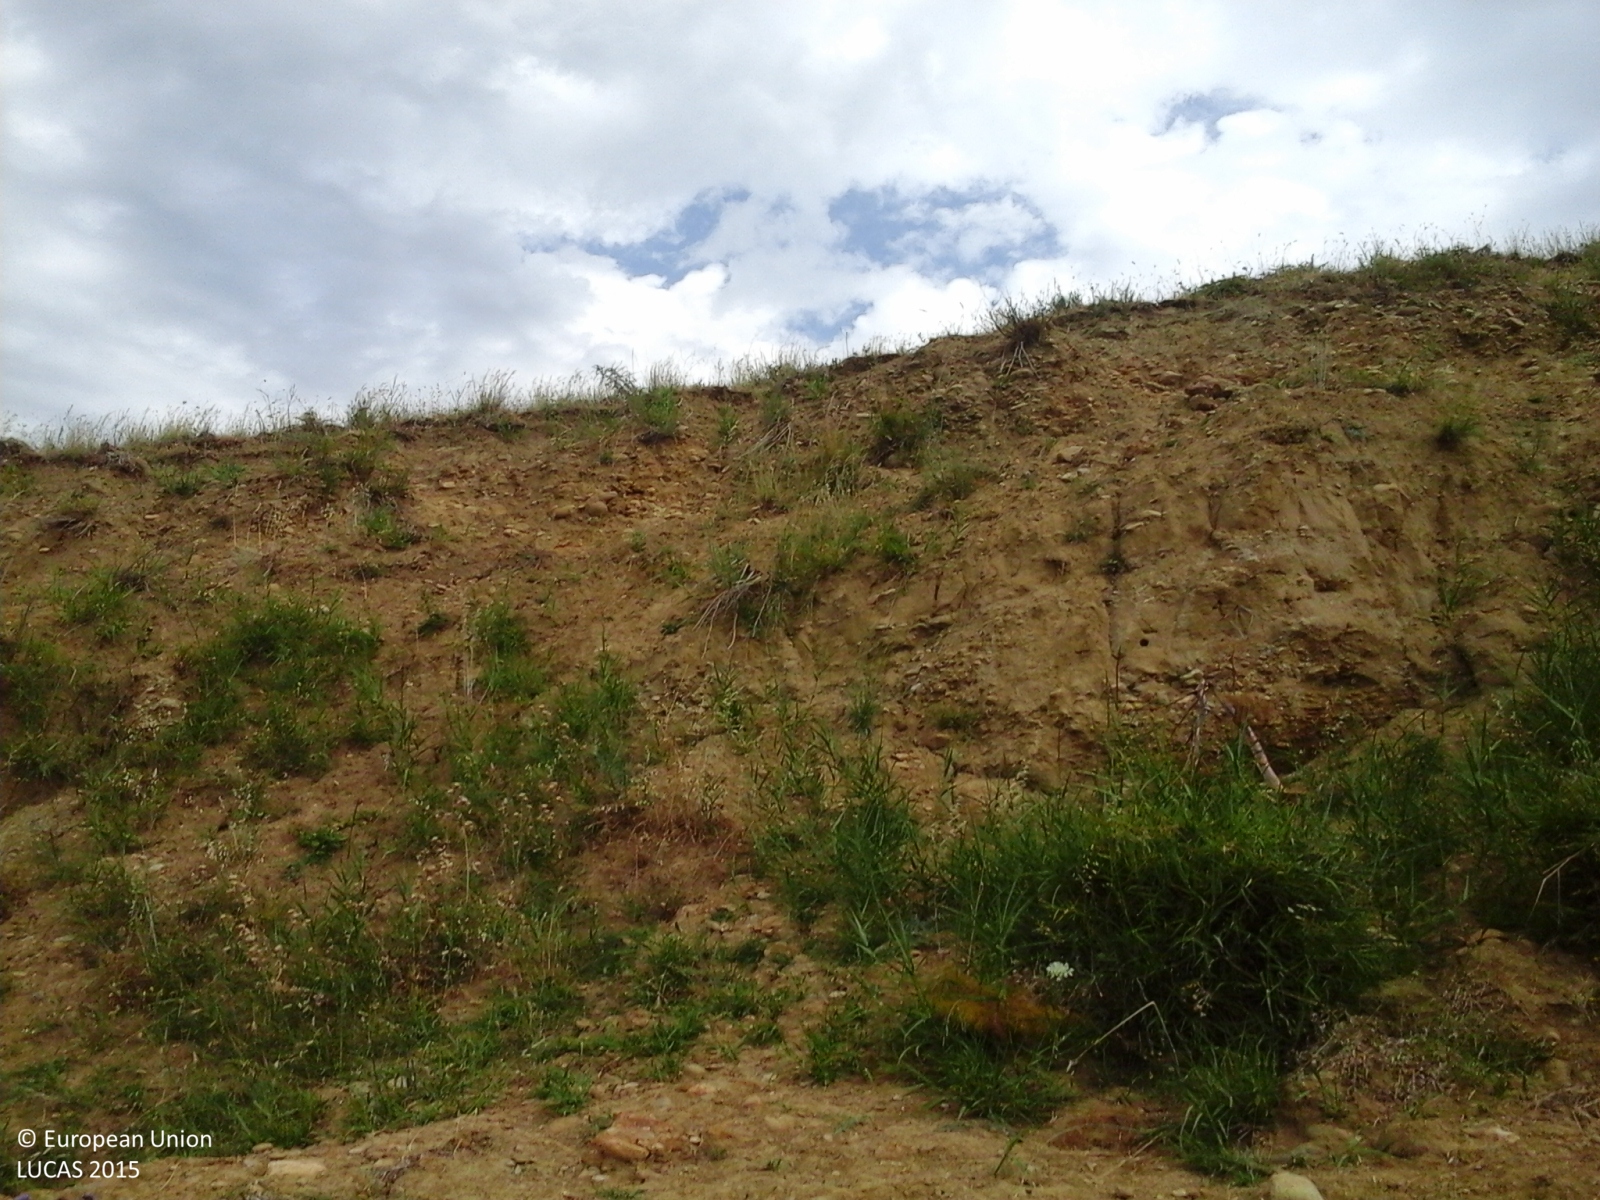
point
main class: Grassland
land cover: Grassland without tree/shrub cover
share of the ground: > 75 %
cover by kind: herbaceous plants 100 %
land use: Agriculture (excluding fallow land and kitchen gardens)
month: June
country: IT
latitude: 37.8757
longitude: 13.6912
